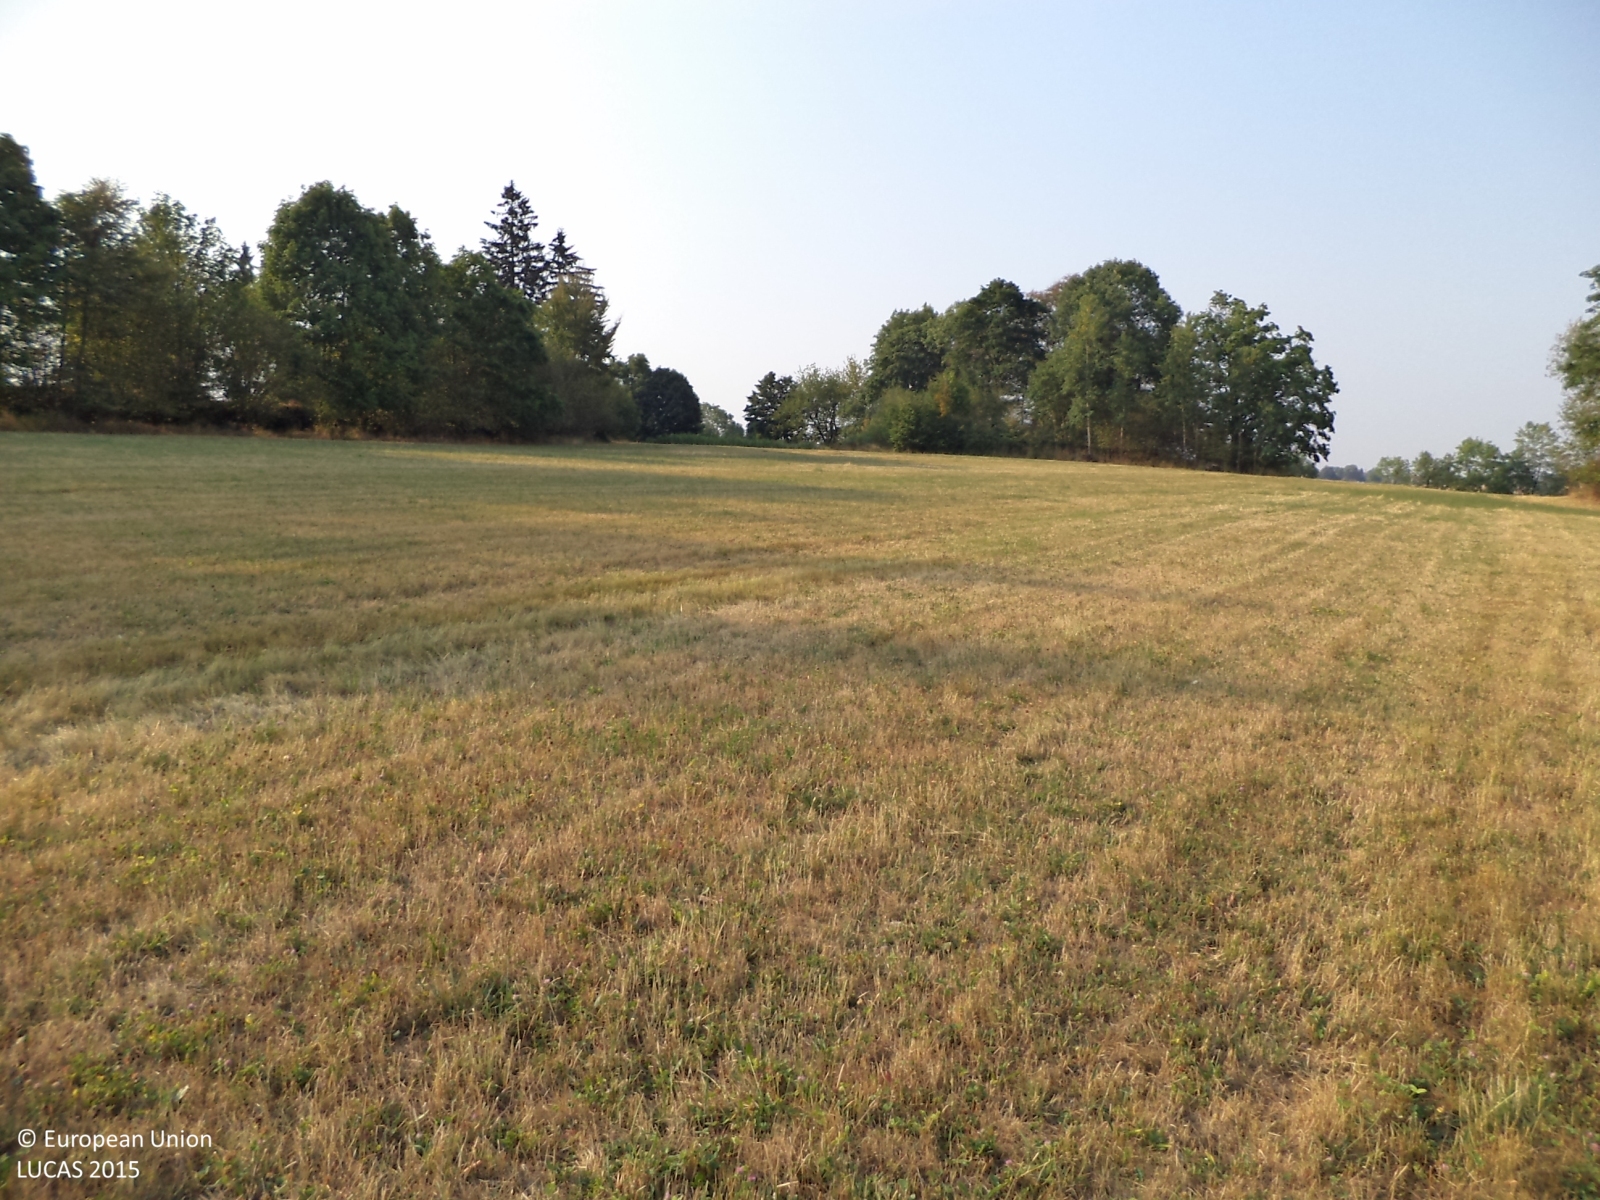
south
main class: Grassland
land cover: Grassland without tree/shrub cover
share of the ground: > 75 %
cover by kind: herbaceous plants 100 %
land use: Agriculture (excluding fallow land and kitchen gardens)
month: August
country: CZ
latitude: 49.5396
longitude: 14.4373
